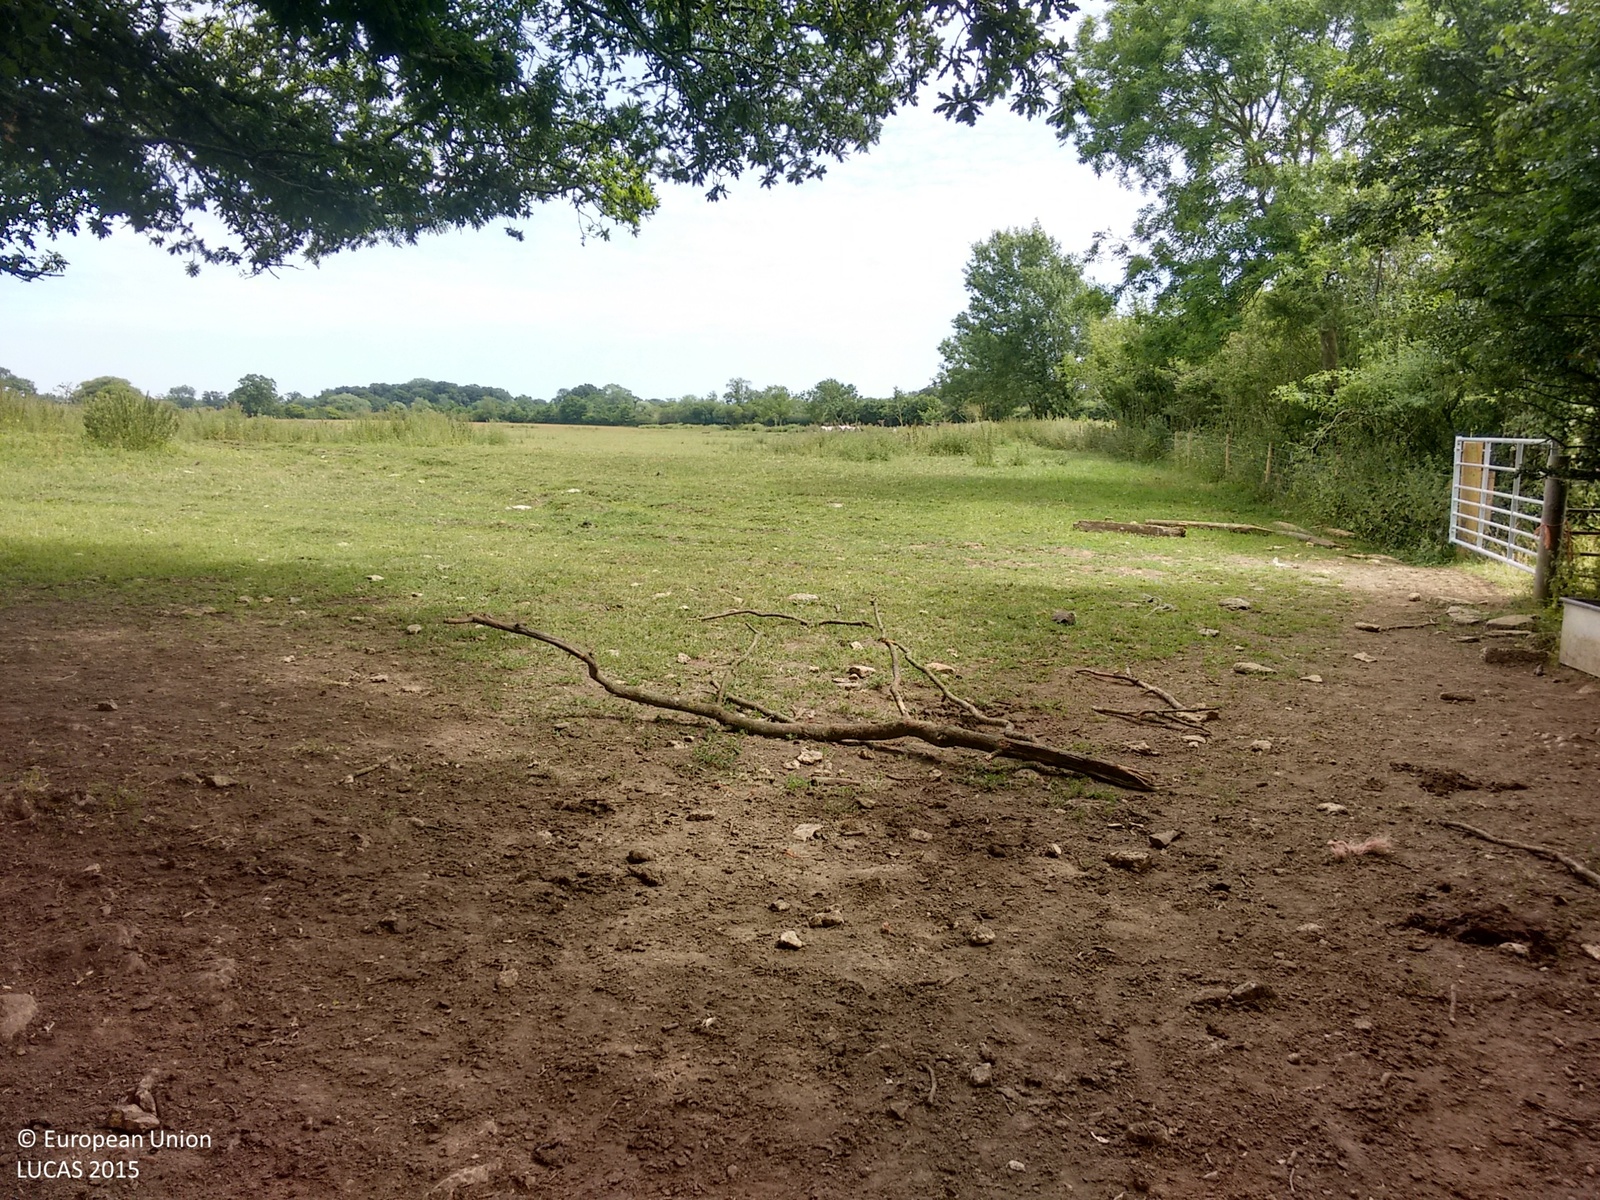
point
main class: Grassland
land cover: Grassland without tree/shrub cover
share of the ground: > 75 %
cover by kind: herbaceous plants 100 %
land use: Agriculture (excluding fallow land and kitchen gardens)
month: July
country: GB
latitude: 51.0297
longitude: -2.4275
